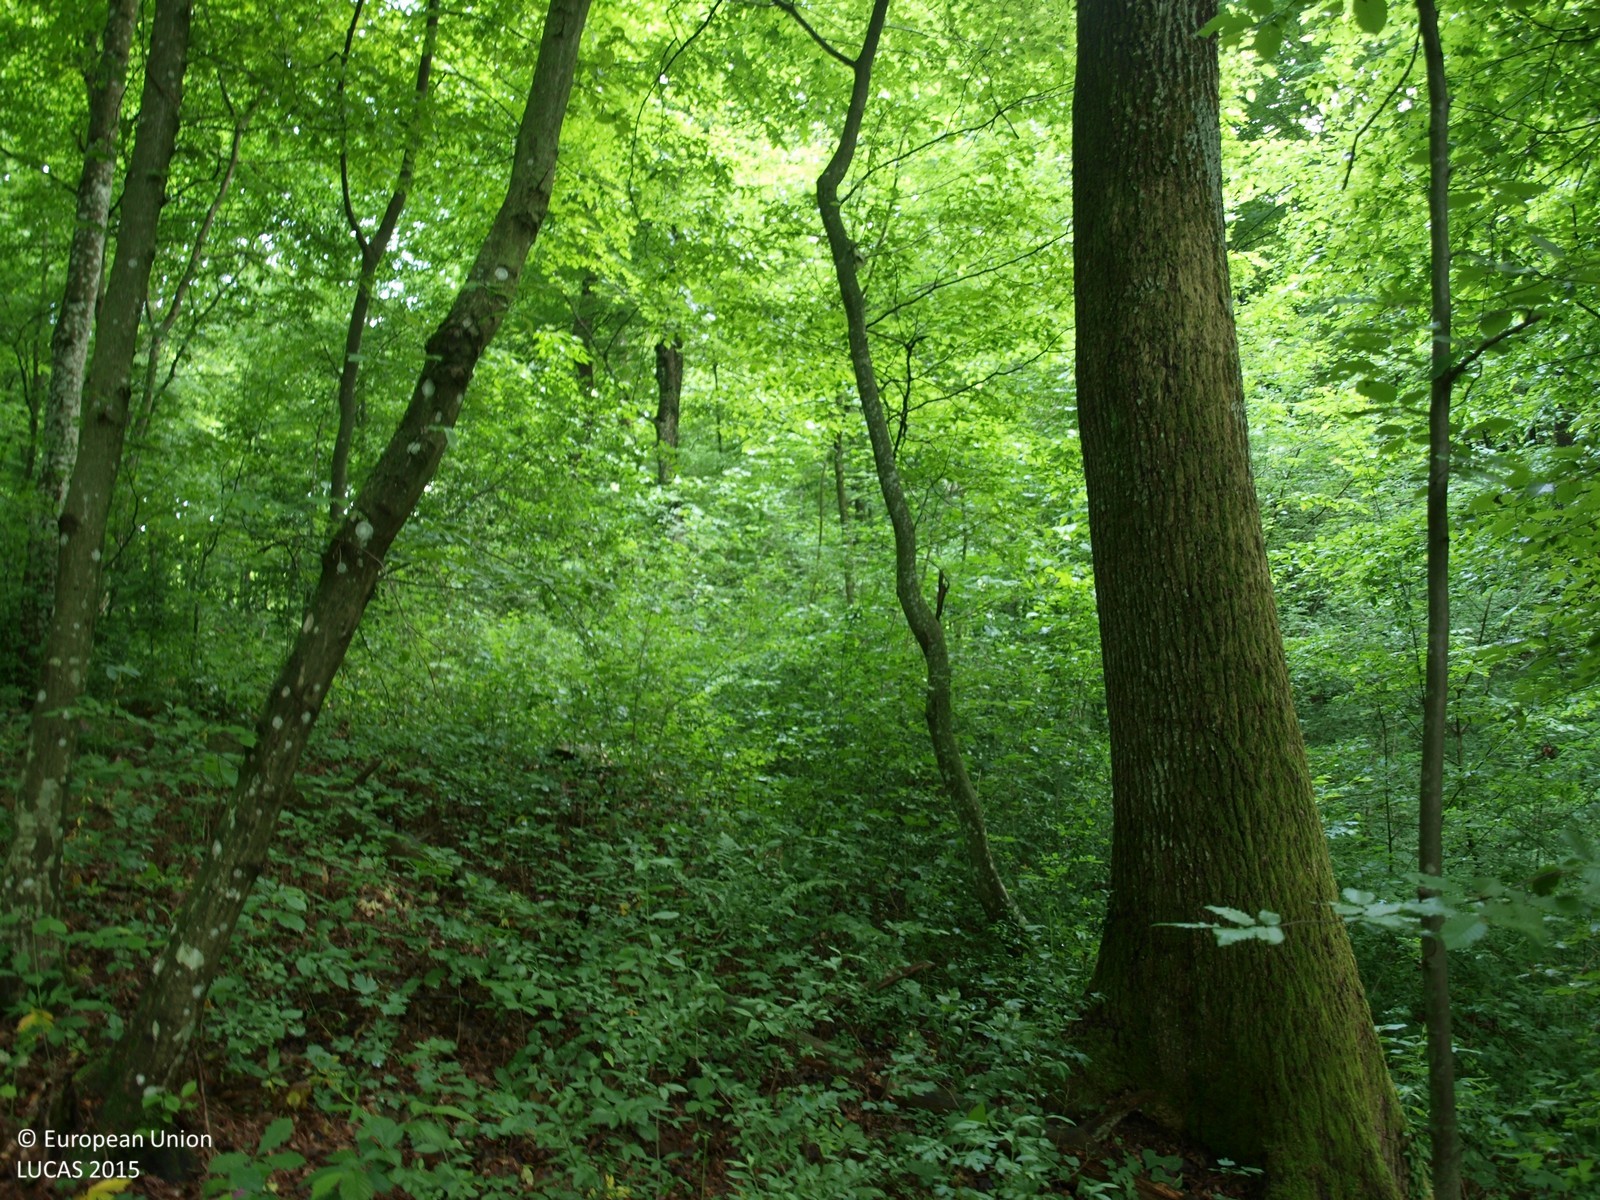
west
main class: Woodland
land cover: Broadleaved woodland
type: mesophytic deciduous forest
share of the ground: > 75 %
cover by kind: broadleaved forest trees 95 %, shrubs 5 %
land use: Forestry
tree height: > 5 m
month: May
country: HR
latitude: 46.1352
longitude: 16.1995
